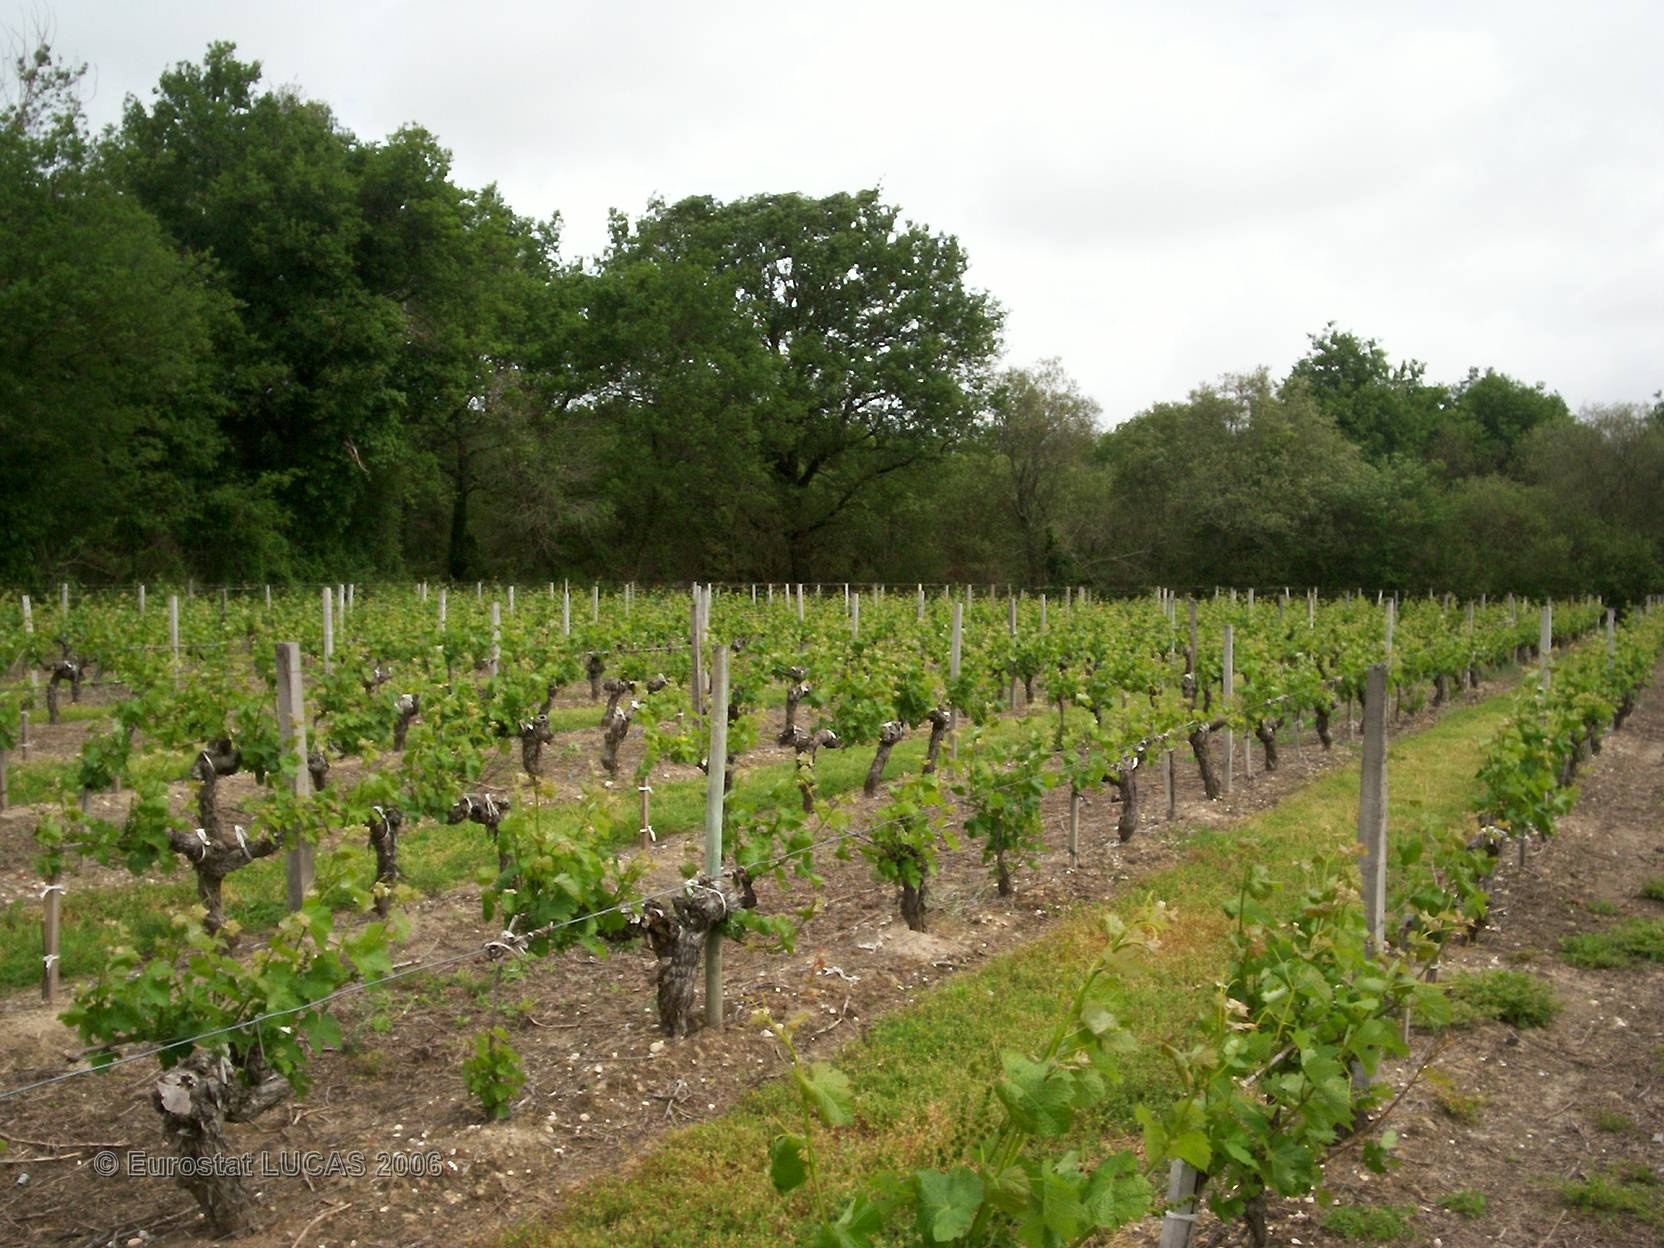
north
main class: Cropland
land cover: Vineyards
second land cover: Grassland with sparse tree/shrub cover
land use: Agriculture (excluding fallow land and kitchen gardens)
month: May
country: FR
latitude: 45.4031
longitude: -0.9746
